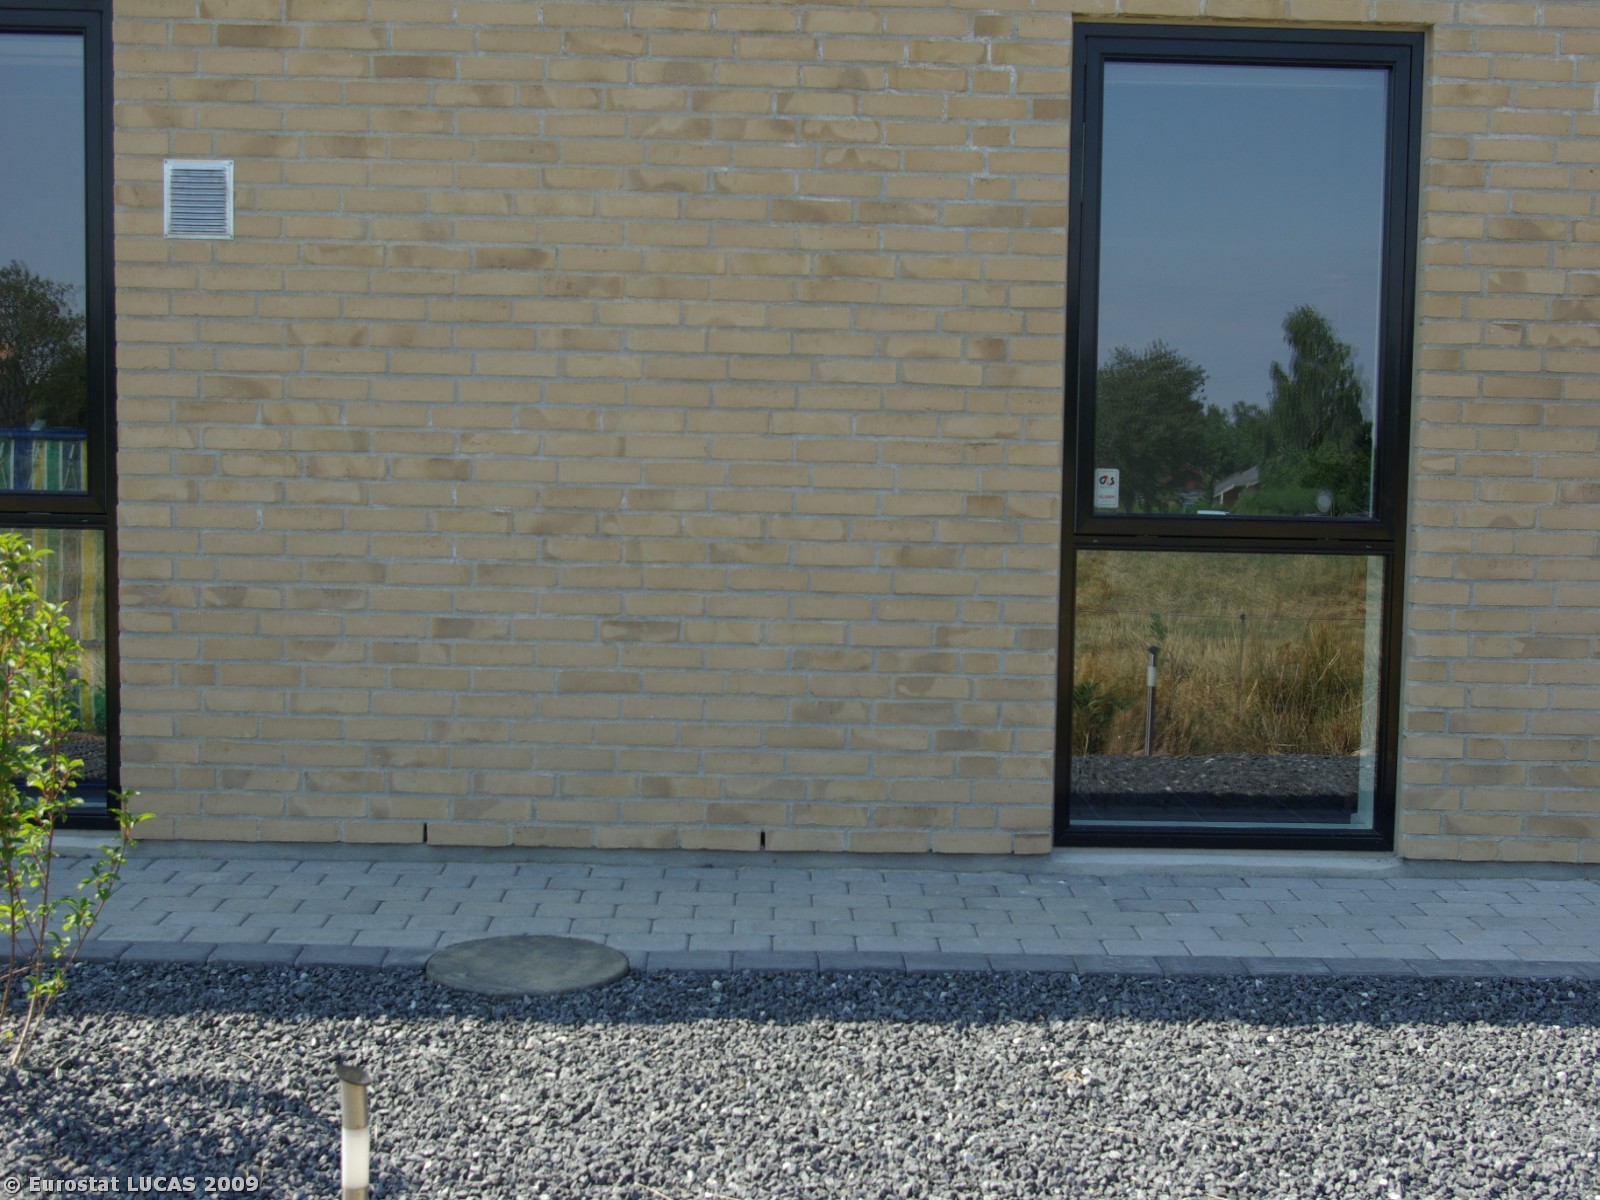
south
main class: Grassland
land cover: Grassland without tree/shrub cover
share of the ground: > 75 %
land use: Agriculture (excluding fallow land and kitchen gardens)
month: July
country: DK
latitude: 54.9472
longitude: 9.7036
